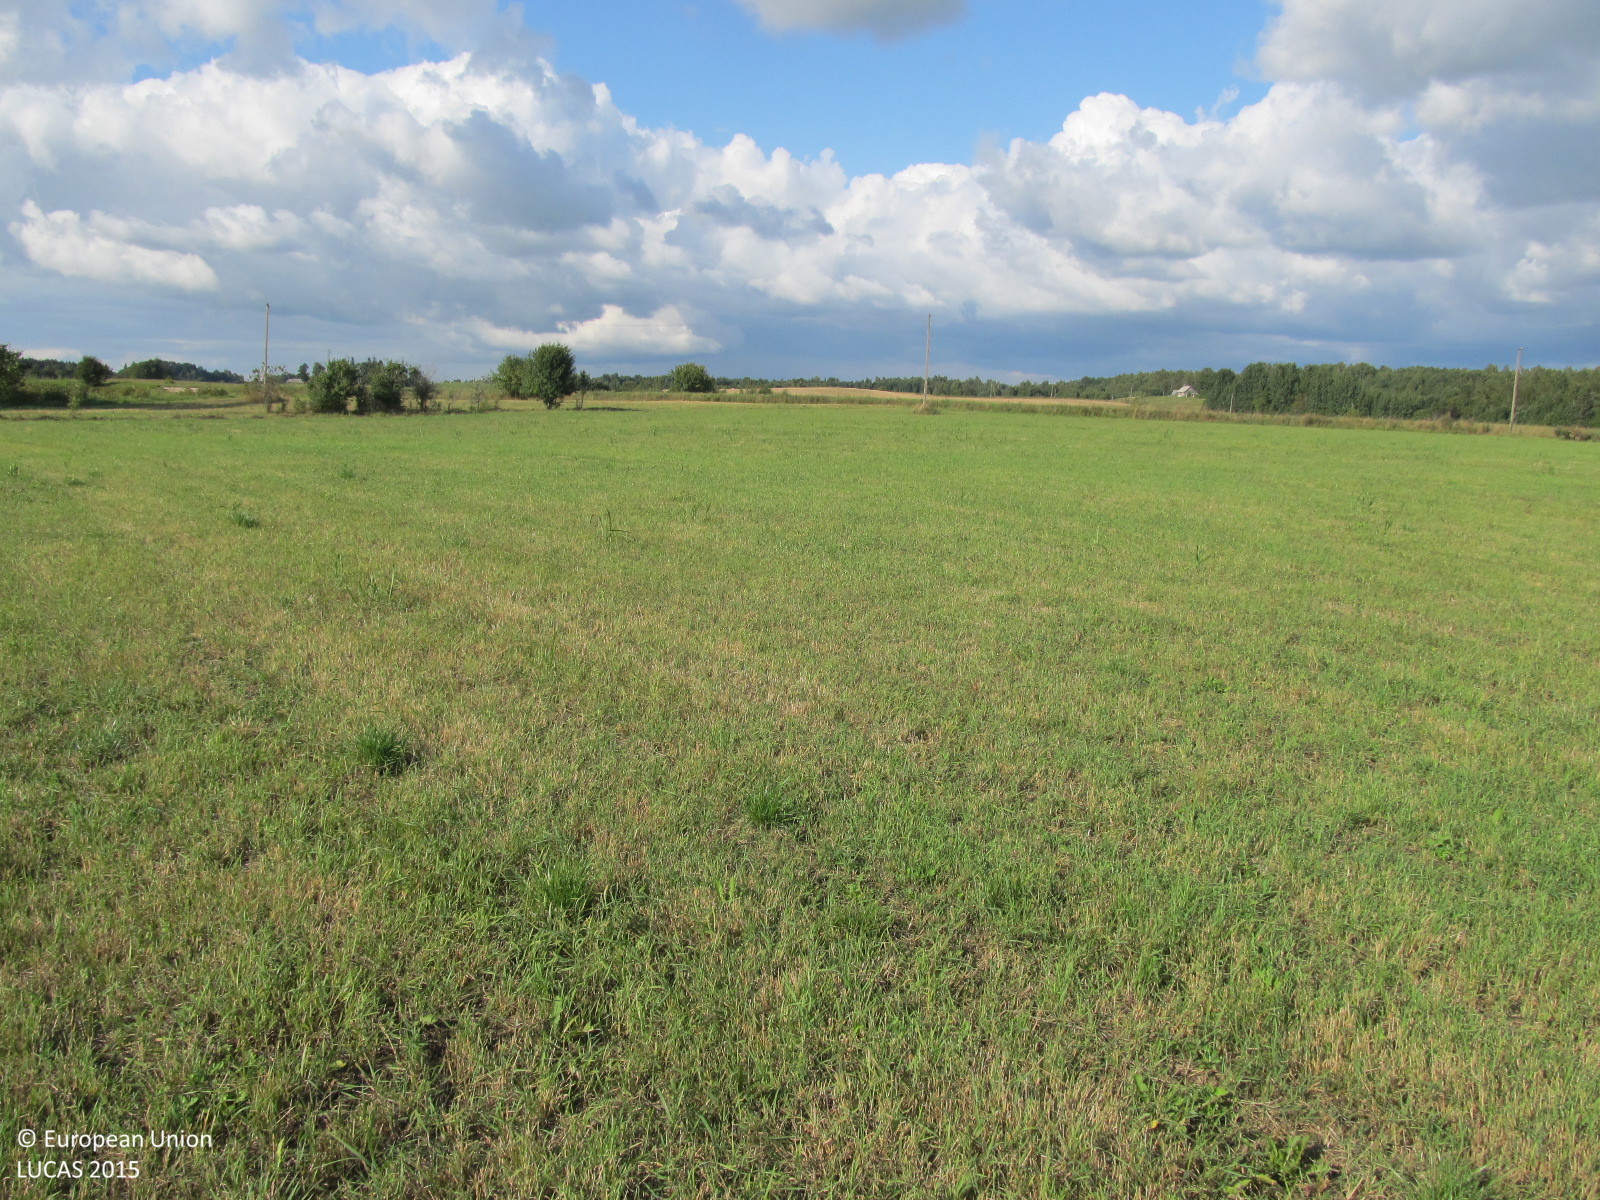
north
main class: Grassland
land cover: Grassland without tree/shrub cover
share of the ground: > 75 %
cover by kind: herbaceous plants 100 %
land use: Agriculture (excluding fallow land and kitchen gardens)
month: September
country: LT
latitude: 55.6690
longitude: 22.6388
